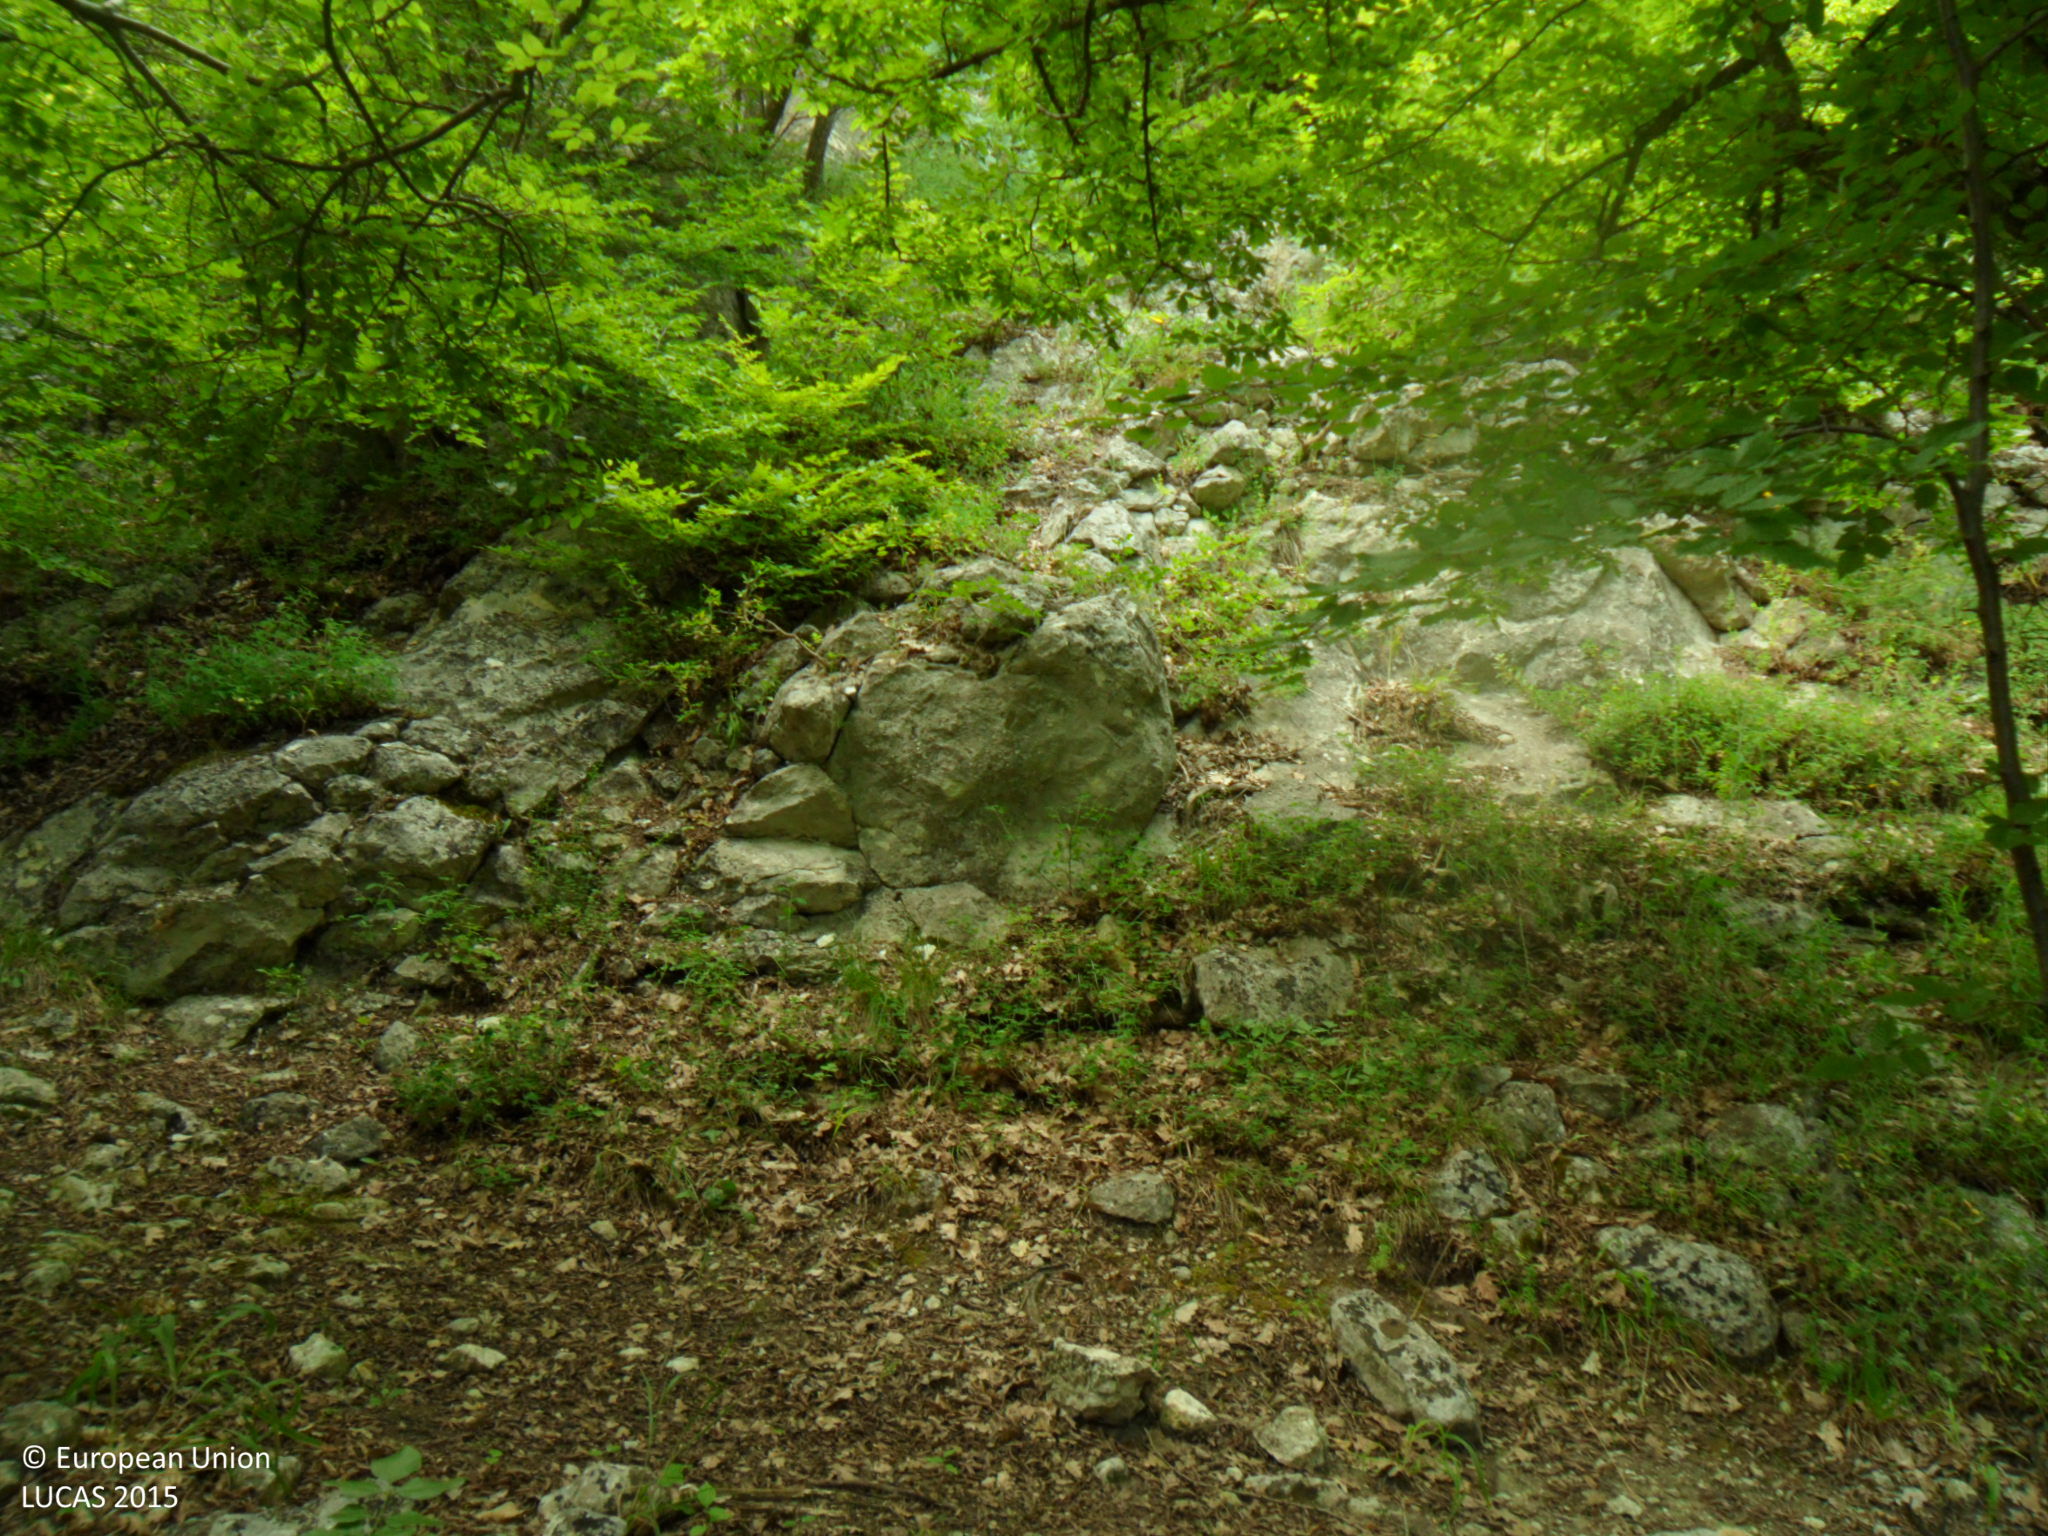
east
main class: Woodland
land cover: Broadleaved woodland
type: beech forest
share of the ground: > 75 %
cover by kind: broadleaved forest trees 100 %
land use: Forestry
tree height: > 5 m
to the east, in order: Broadleaved woodland; Grassland with sparse tree/shrub cover; Other bare soil; Broadleaved woodland; Rocks and stones; Grassland with sparse tree/shrub cover; Broadleaved woodland
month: June
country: BG
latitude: 43.3195
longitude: 26.7934
